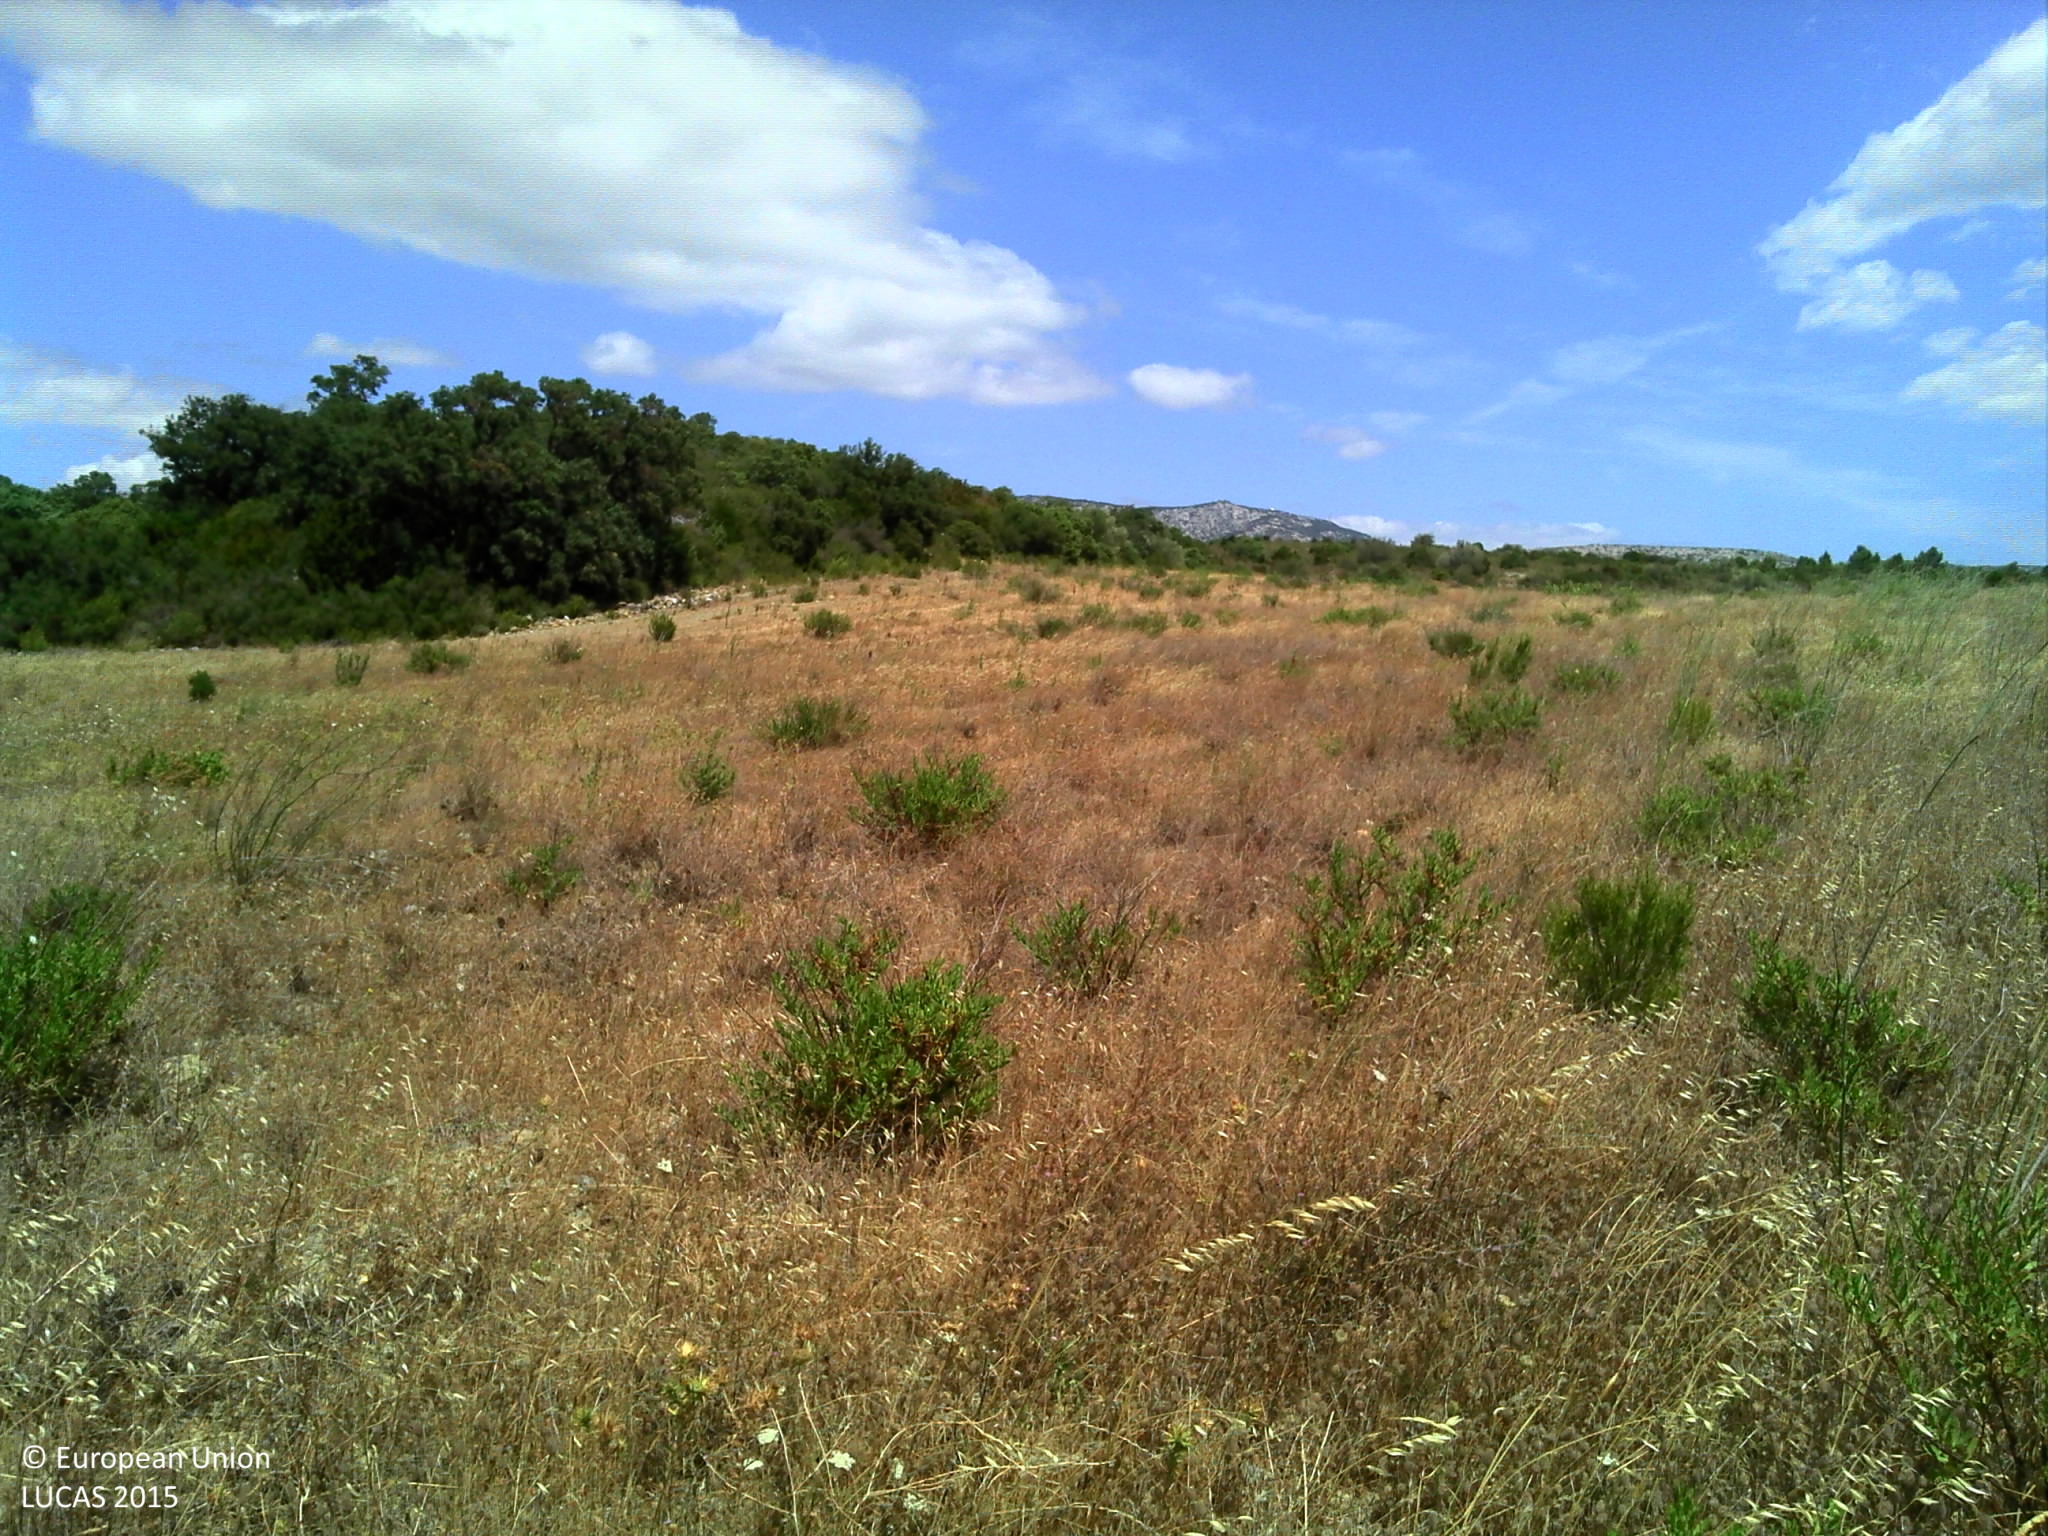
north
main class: Grassland
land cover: Spontaneously vegetated surfaces
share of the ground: > 75 %
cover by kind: herbaceous plants 95 %, shrubs 5 %
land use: Semi-natural and natural areas not in use
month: July
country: FR
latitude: 42.8706
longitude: 2.8254
